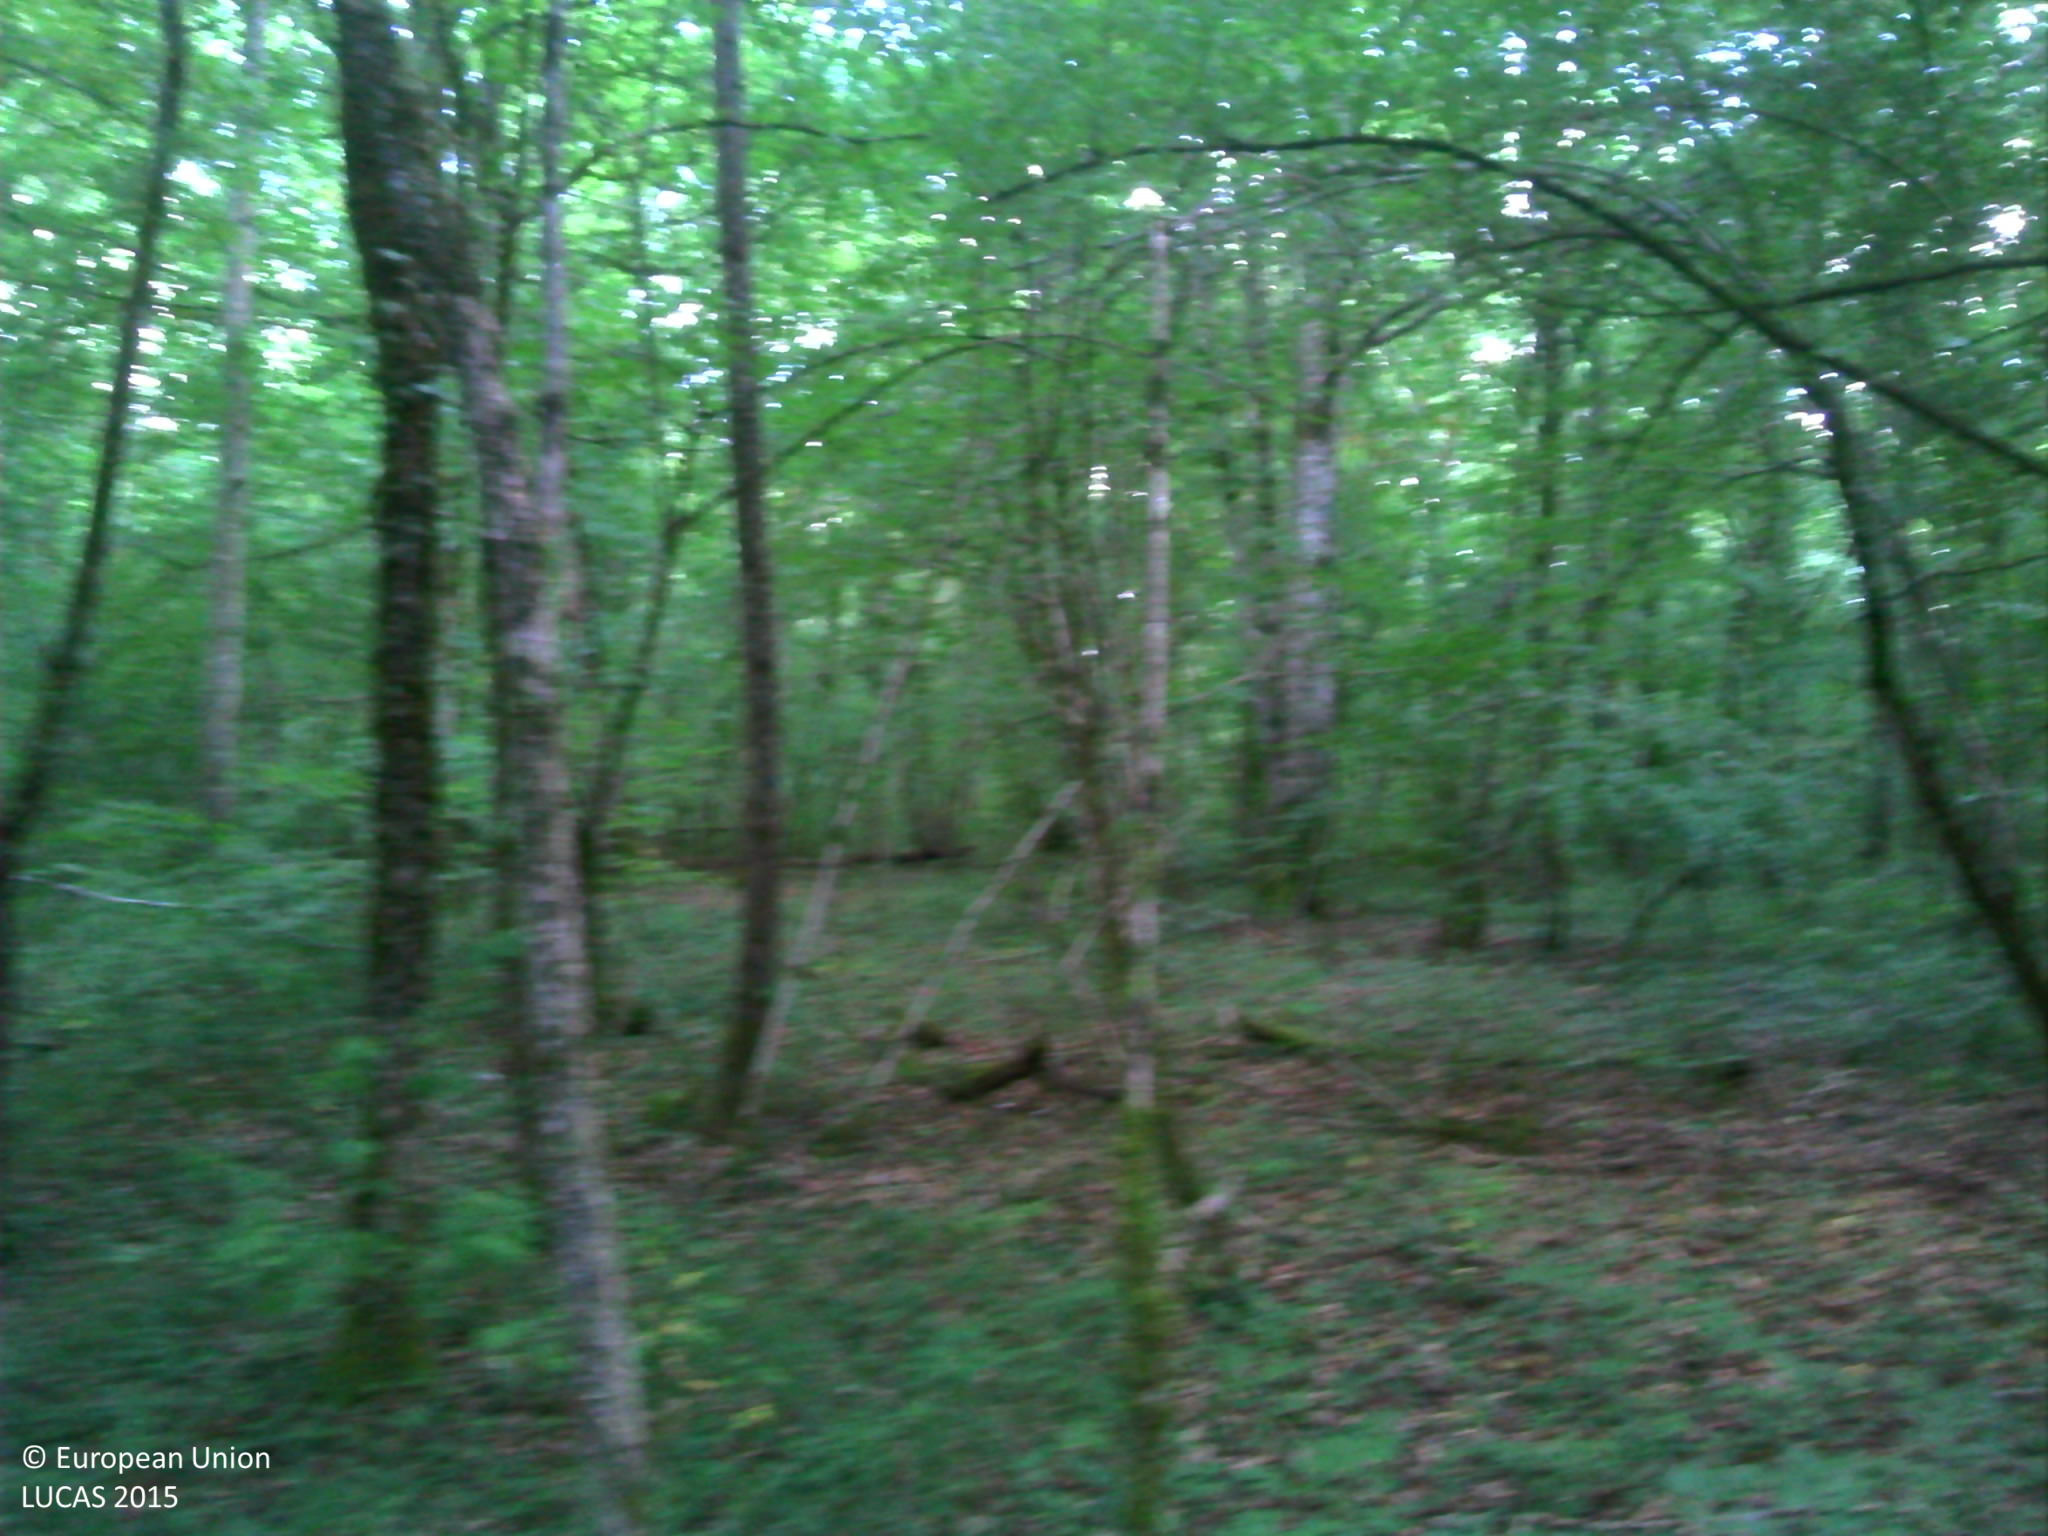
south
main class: Woodland
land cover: Broadleaved woodland
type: acidophilous oak and oak-birch forest
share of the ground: > 75 %
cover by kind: broadleaved forest trees 85 %, herbaceous plants 10 %, lichens and mosses 5 %
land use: Forestry
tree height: > 5 m
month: July
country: FR
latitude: 47.8751
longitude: 4.9854
